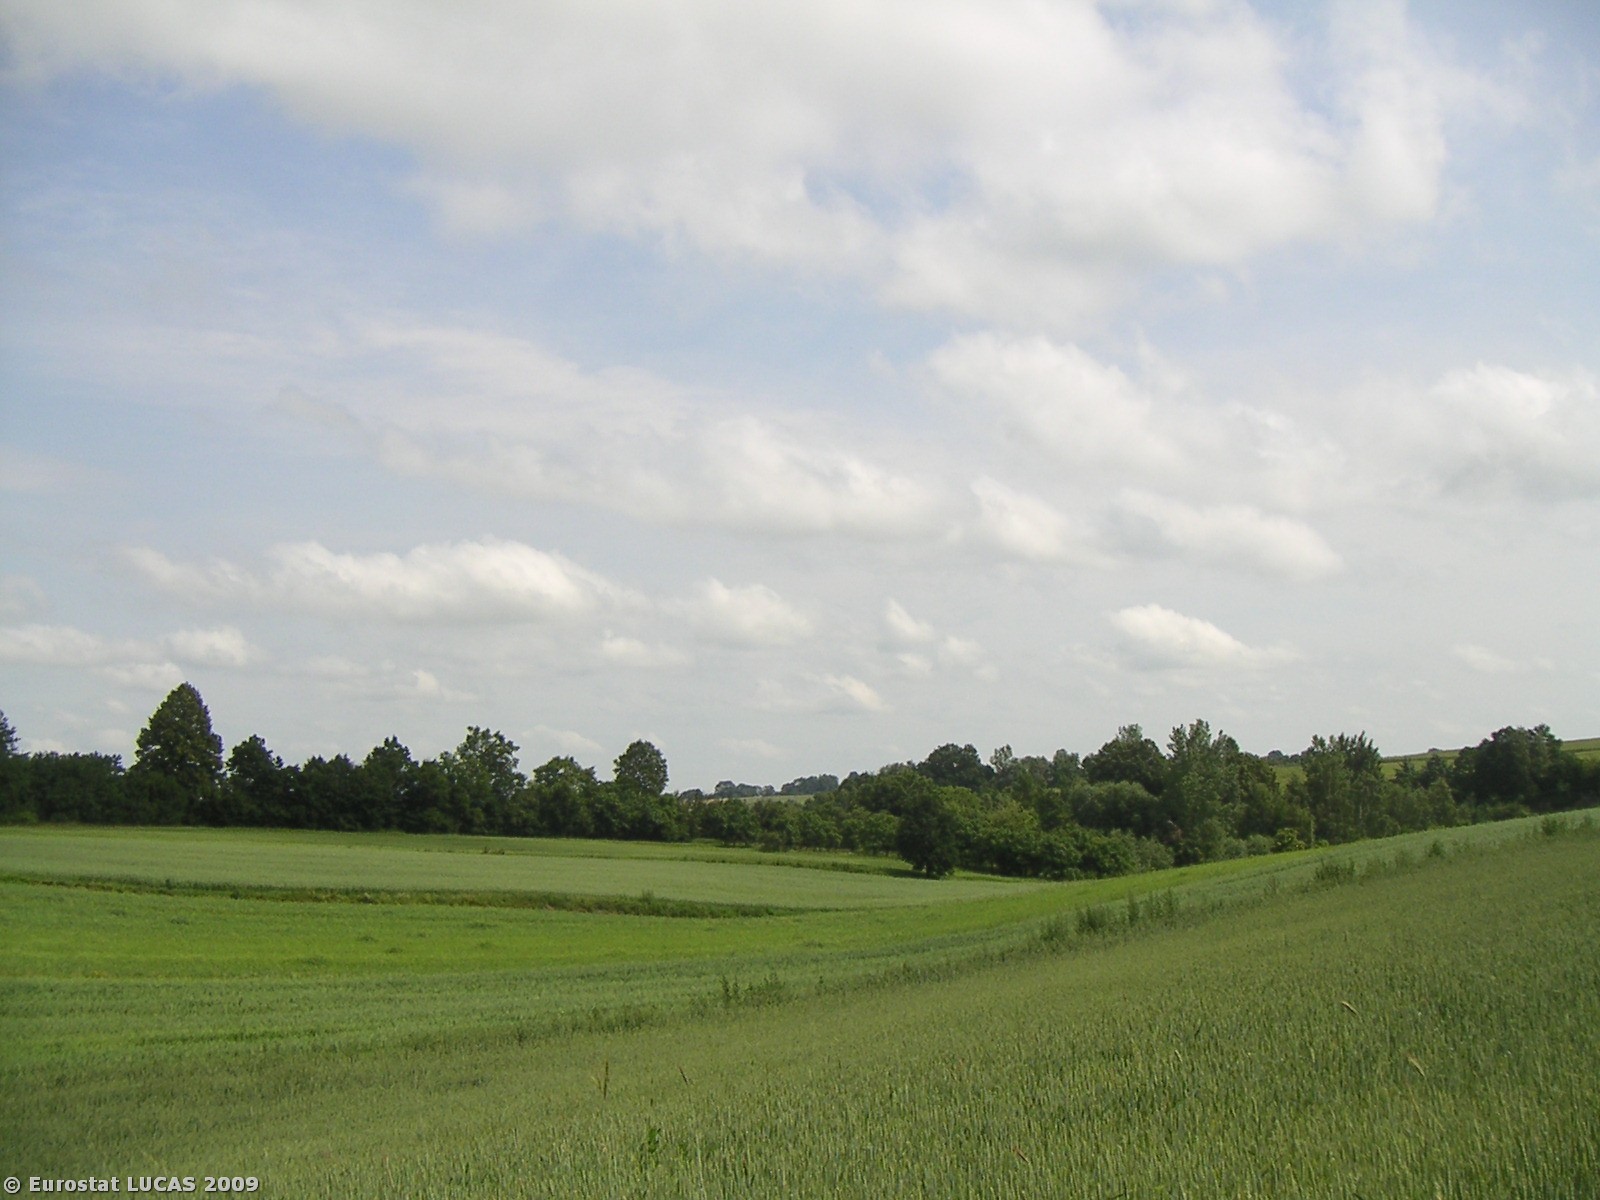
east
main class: Cropland
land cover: Common wheat
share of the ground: > 75 %
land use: Agriculture (excluding fallow land and kitchen gardens)
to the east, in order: Common wheat; Grass margins; Common wheat; Fences; Artificial constructions in urban areas; Fences; Managed hedges
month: June
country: PL
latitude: 50.4301
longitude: 19.8145
